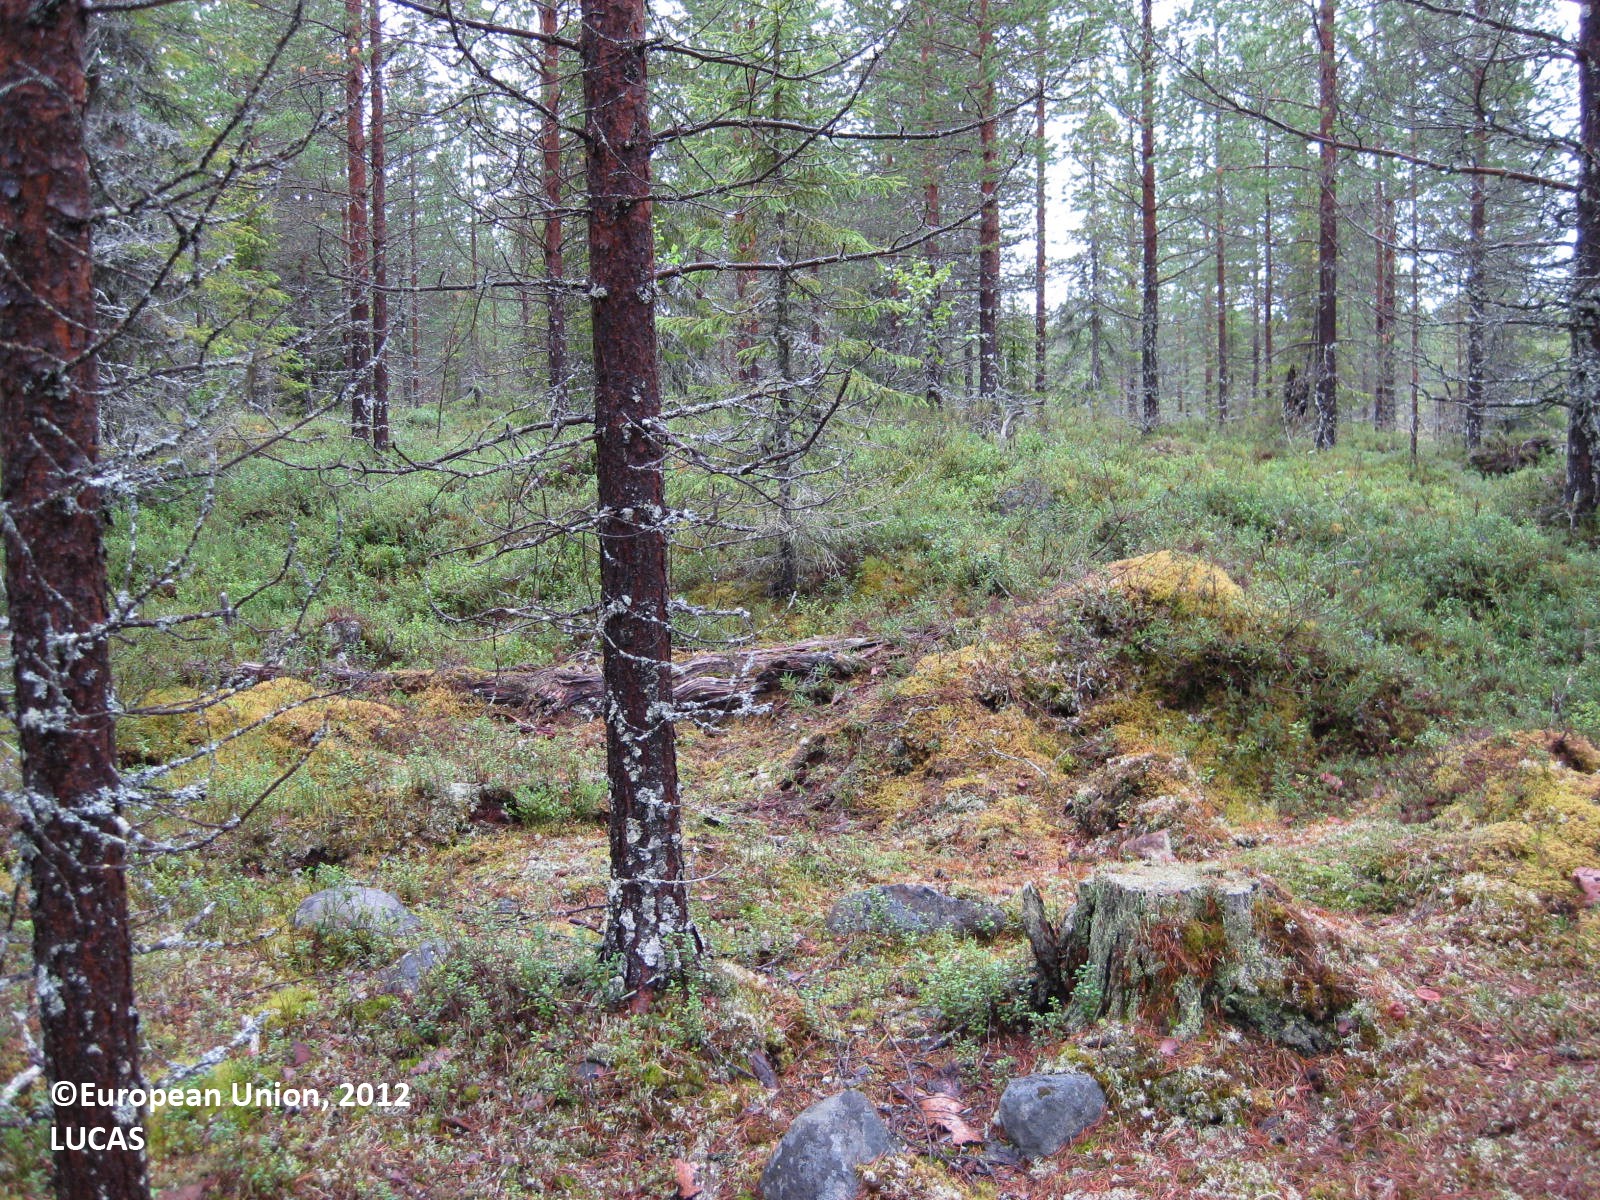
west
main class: Woodland
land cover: Pine dominated coniferous woodland
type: boreal forest
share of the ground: 50 - 75 %
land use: Forestry
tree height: > 5 m
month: August
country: FI
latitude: 65.9539
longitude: 28.2923
